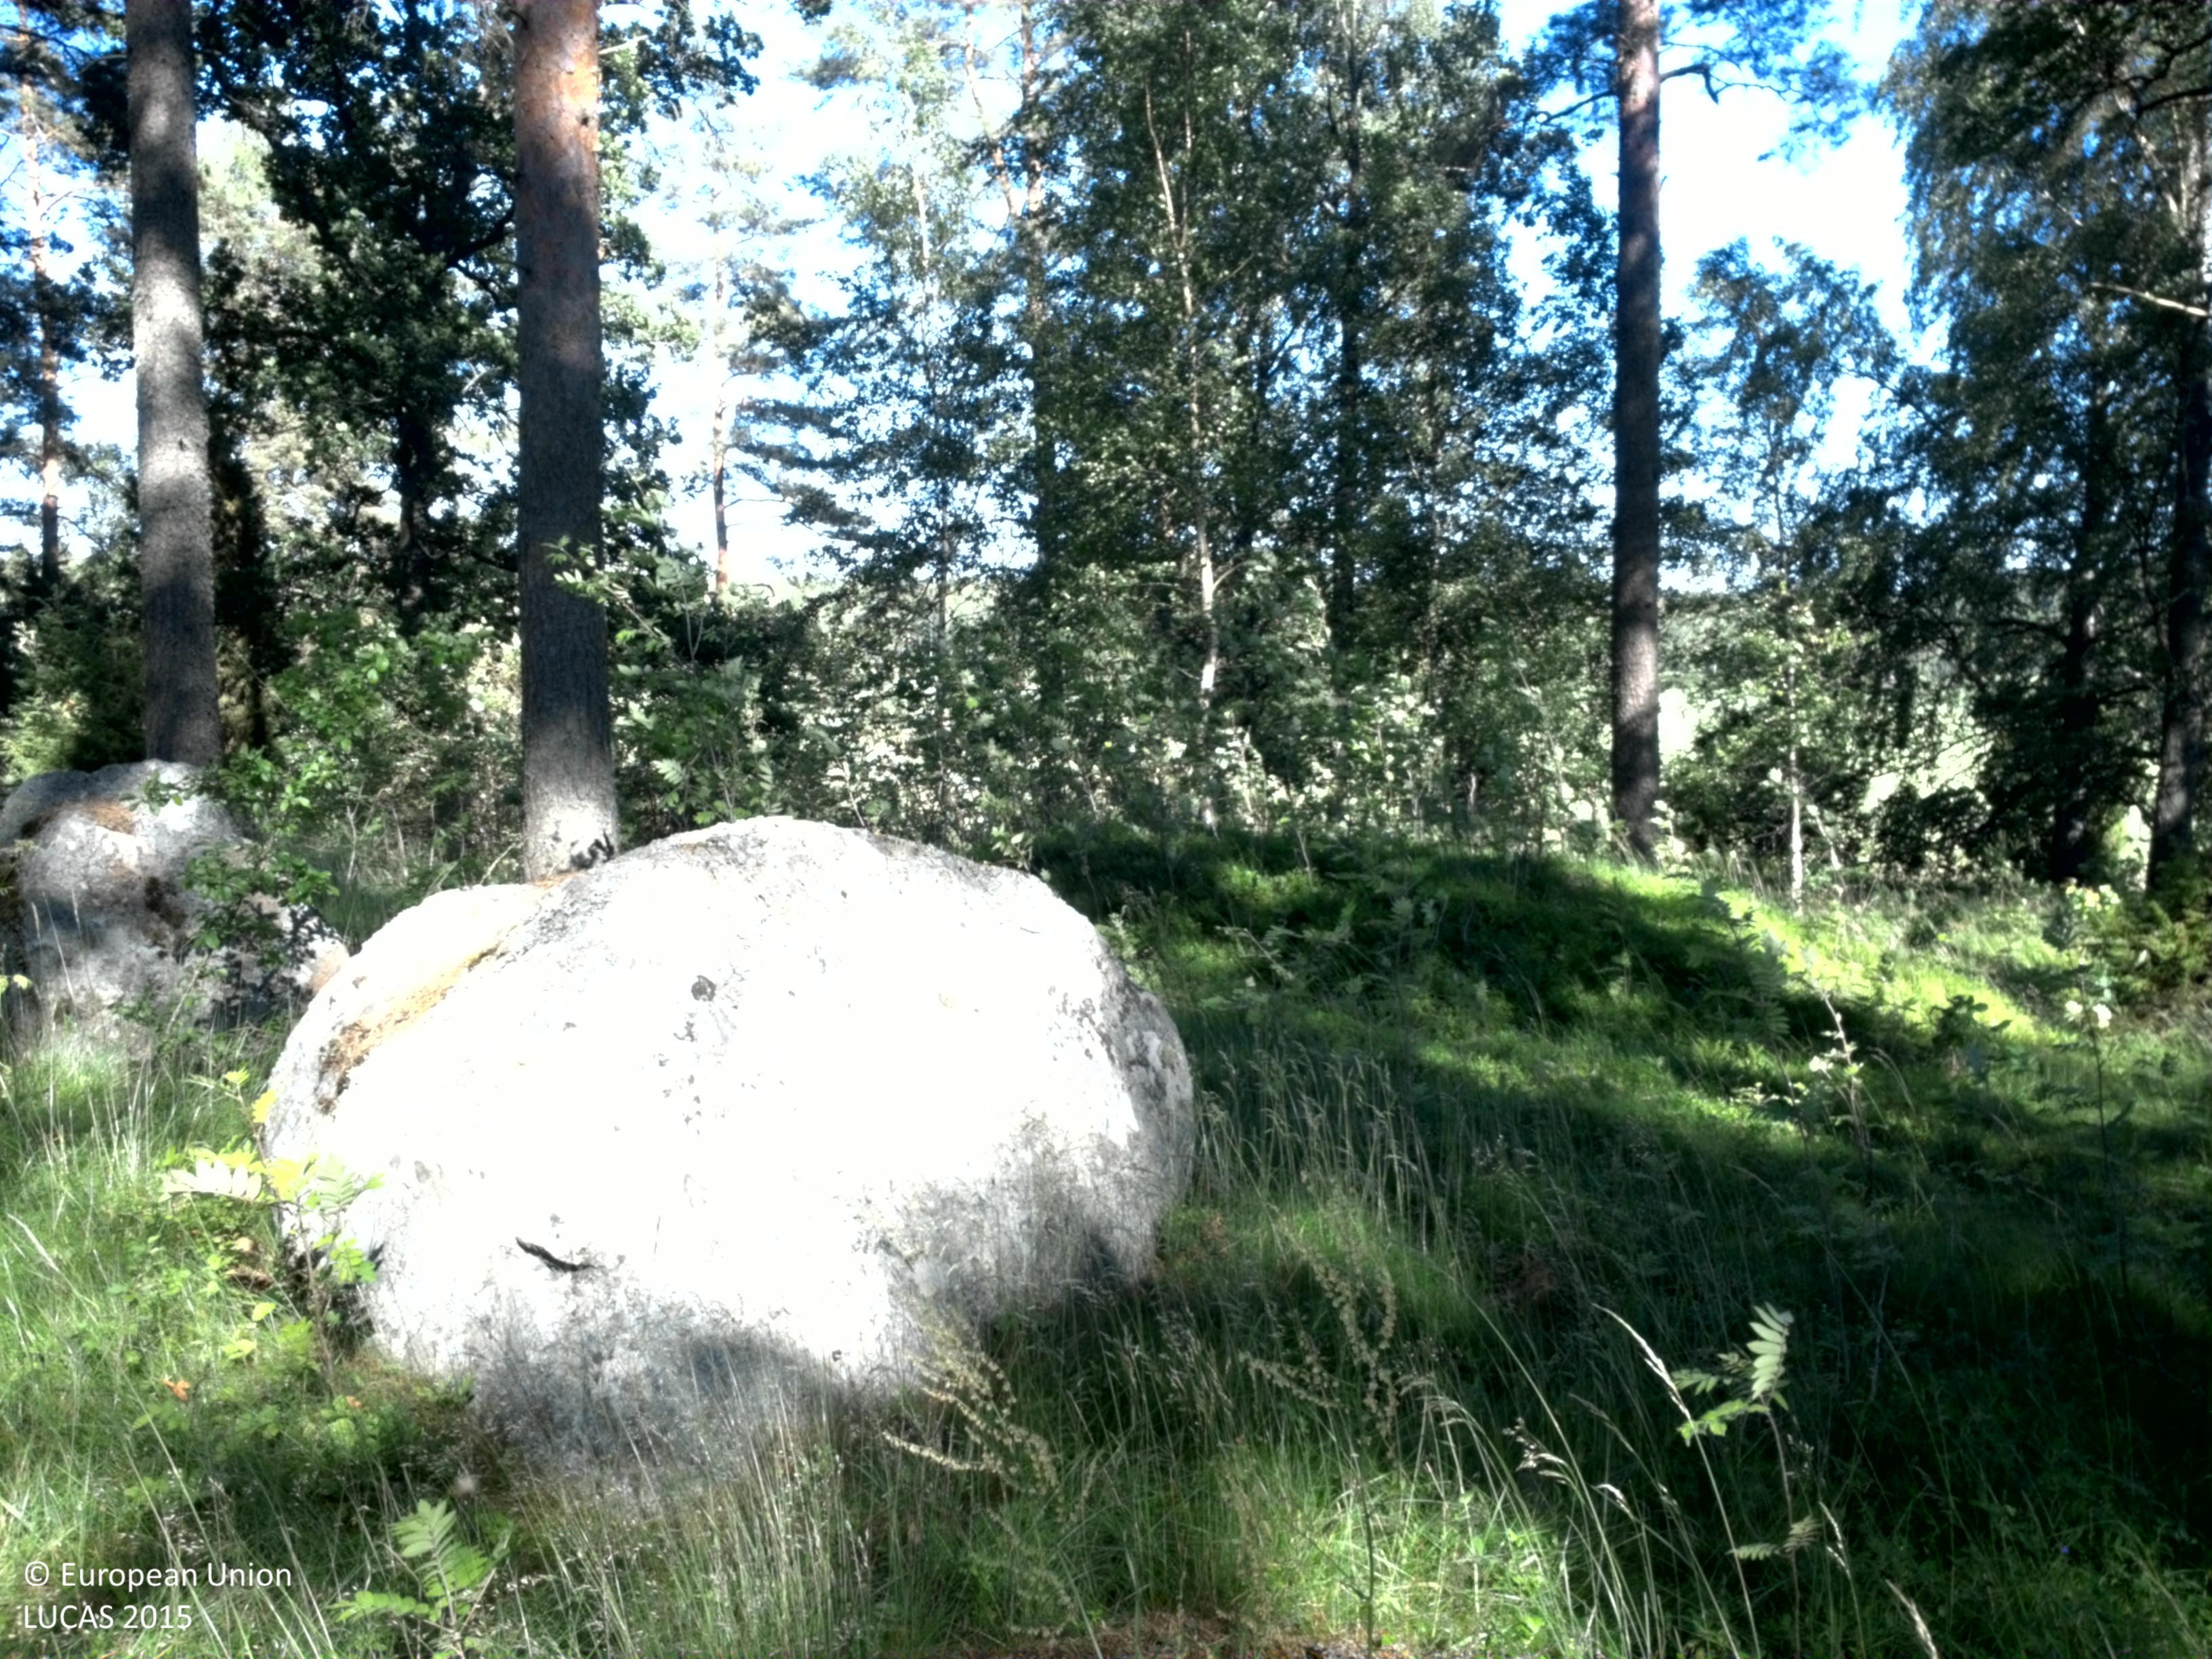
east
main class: Woodland
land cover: Pine dominated coniferous woodland
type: boreal forest
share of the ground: 50 - 75 %
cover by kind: coniferous forest trees 50 %, herbaceous plants 45 %, broadleaved forest trees 5 %
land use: Forestry
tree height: > 5 m
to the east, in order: Pine dominated coniferous woodland; Pine dominated mixed woodland; Grassland without tree/shrub cover; Fences; Grass margins; Ditches and canals; Grass margins; Rape and turnip rape; Grassland without tree/shrub cover
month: July
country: SE
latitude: 59.7436
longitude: 18.4859
